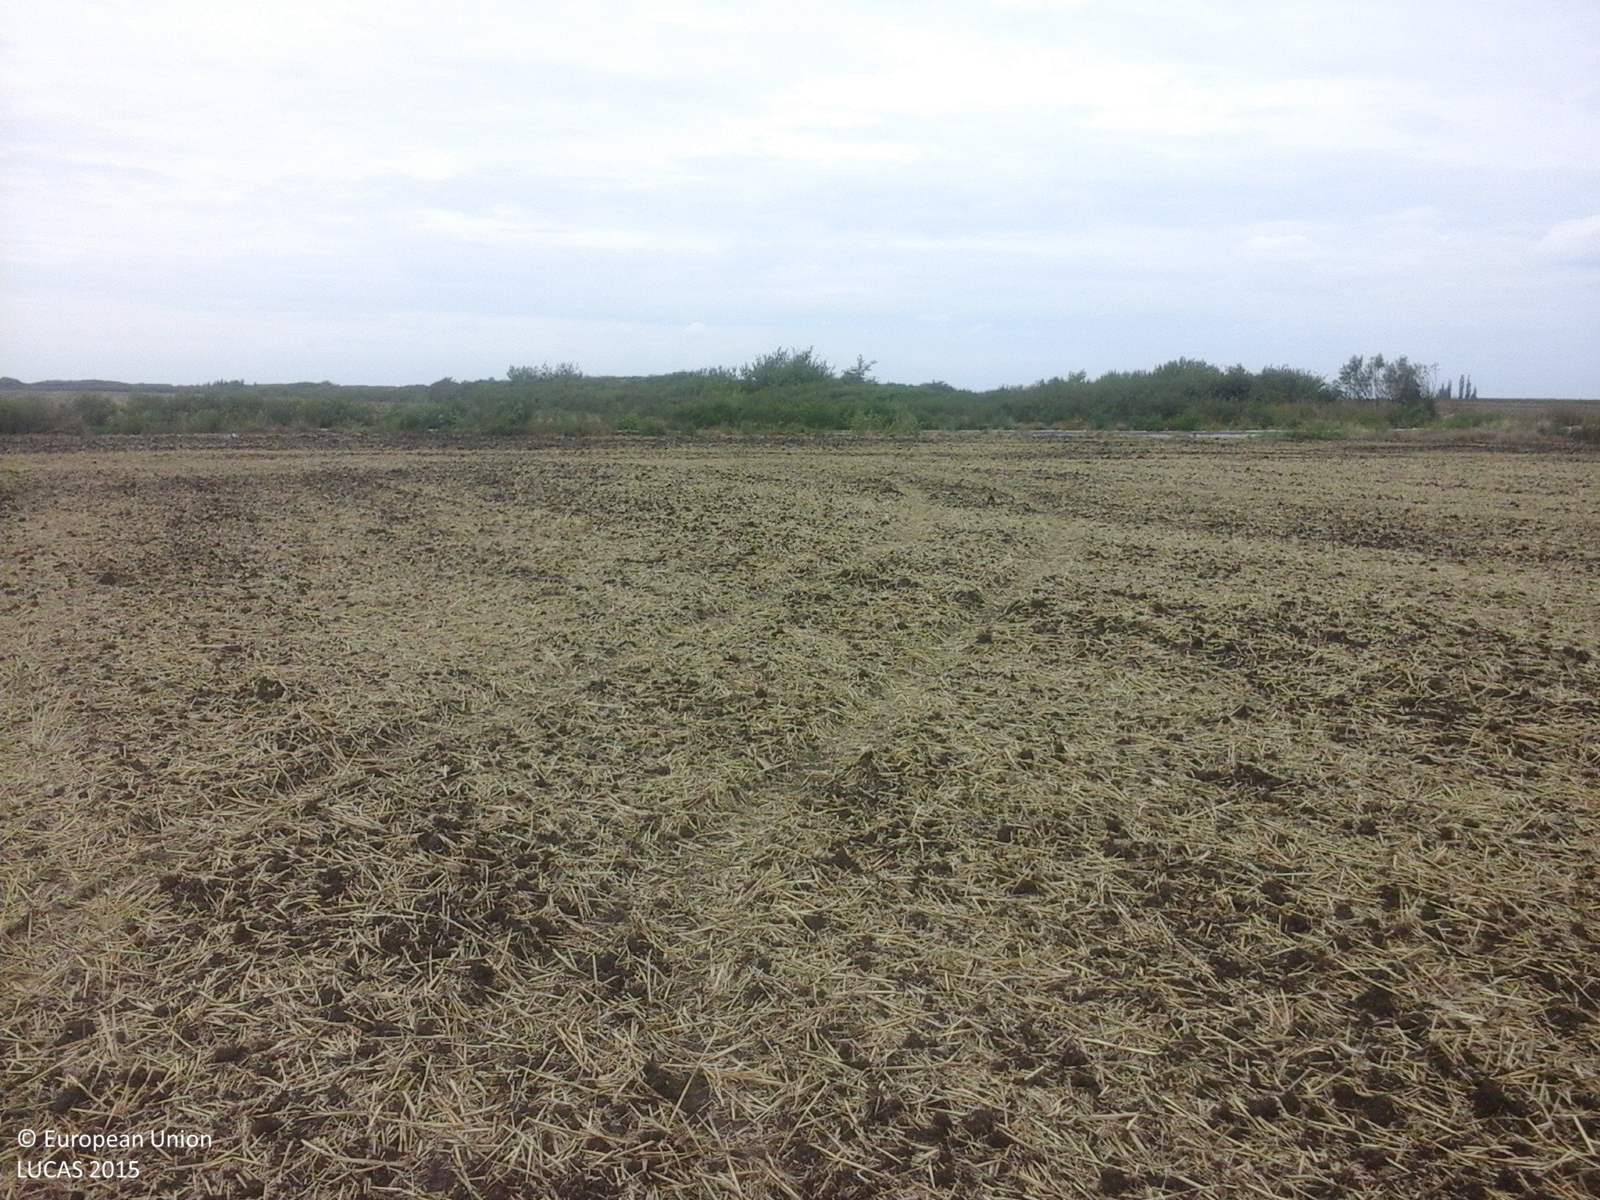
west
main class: Cropland
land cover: Common wheat
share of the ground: 10 - 25 %
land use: Agriculture (excluding fallow land and kitchen gardens)
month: August
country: RO
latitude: 45.5008
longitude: 21.2531
